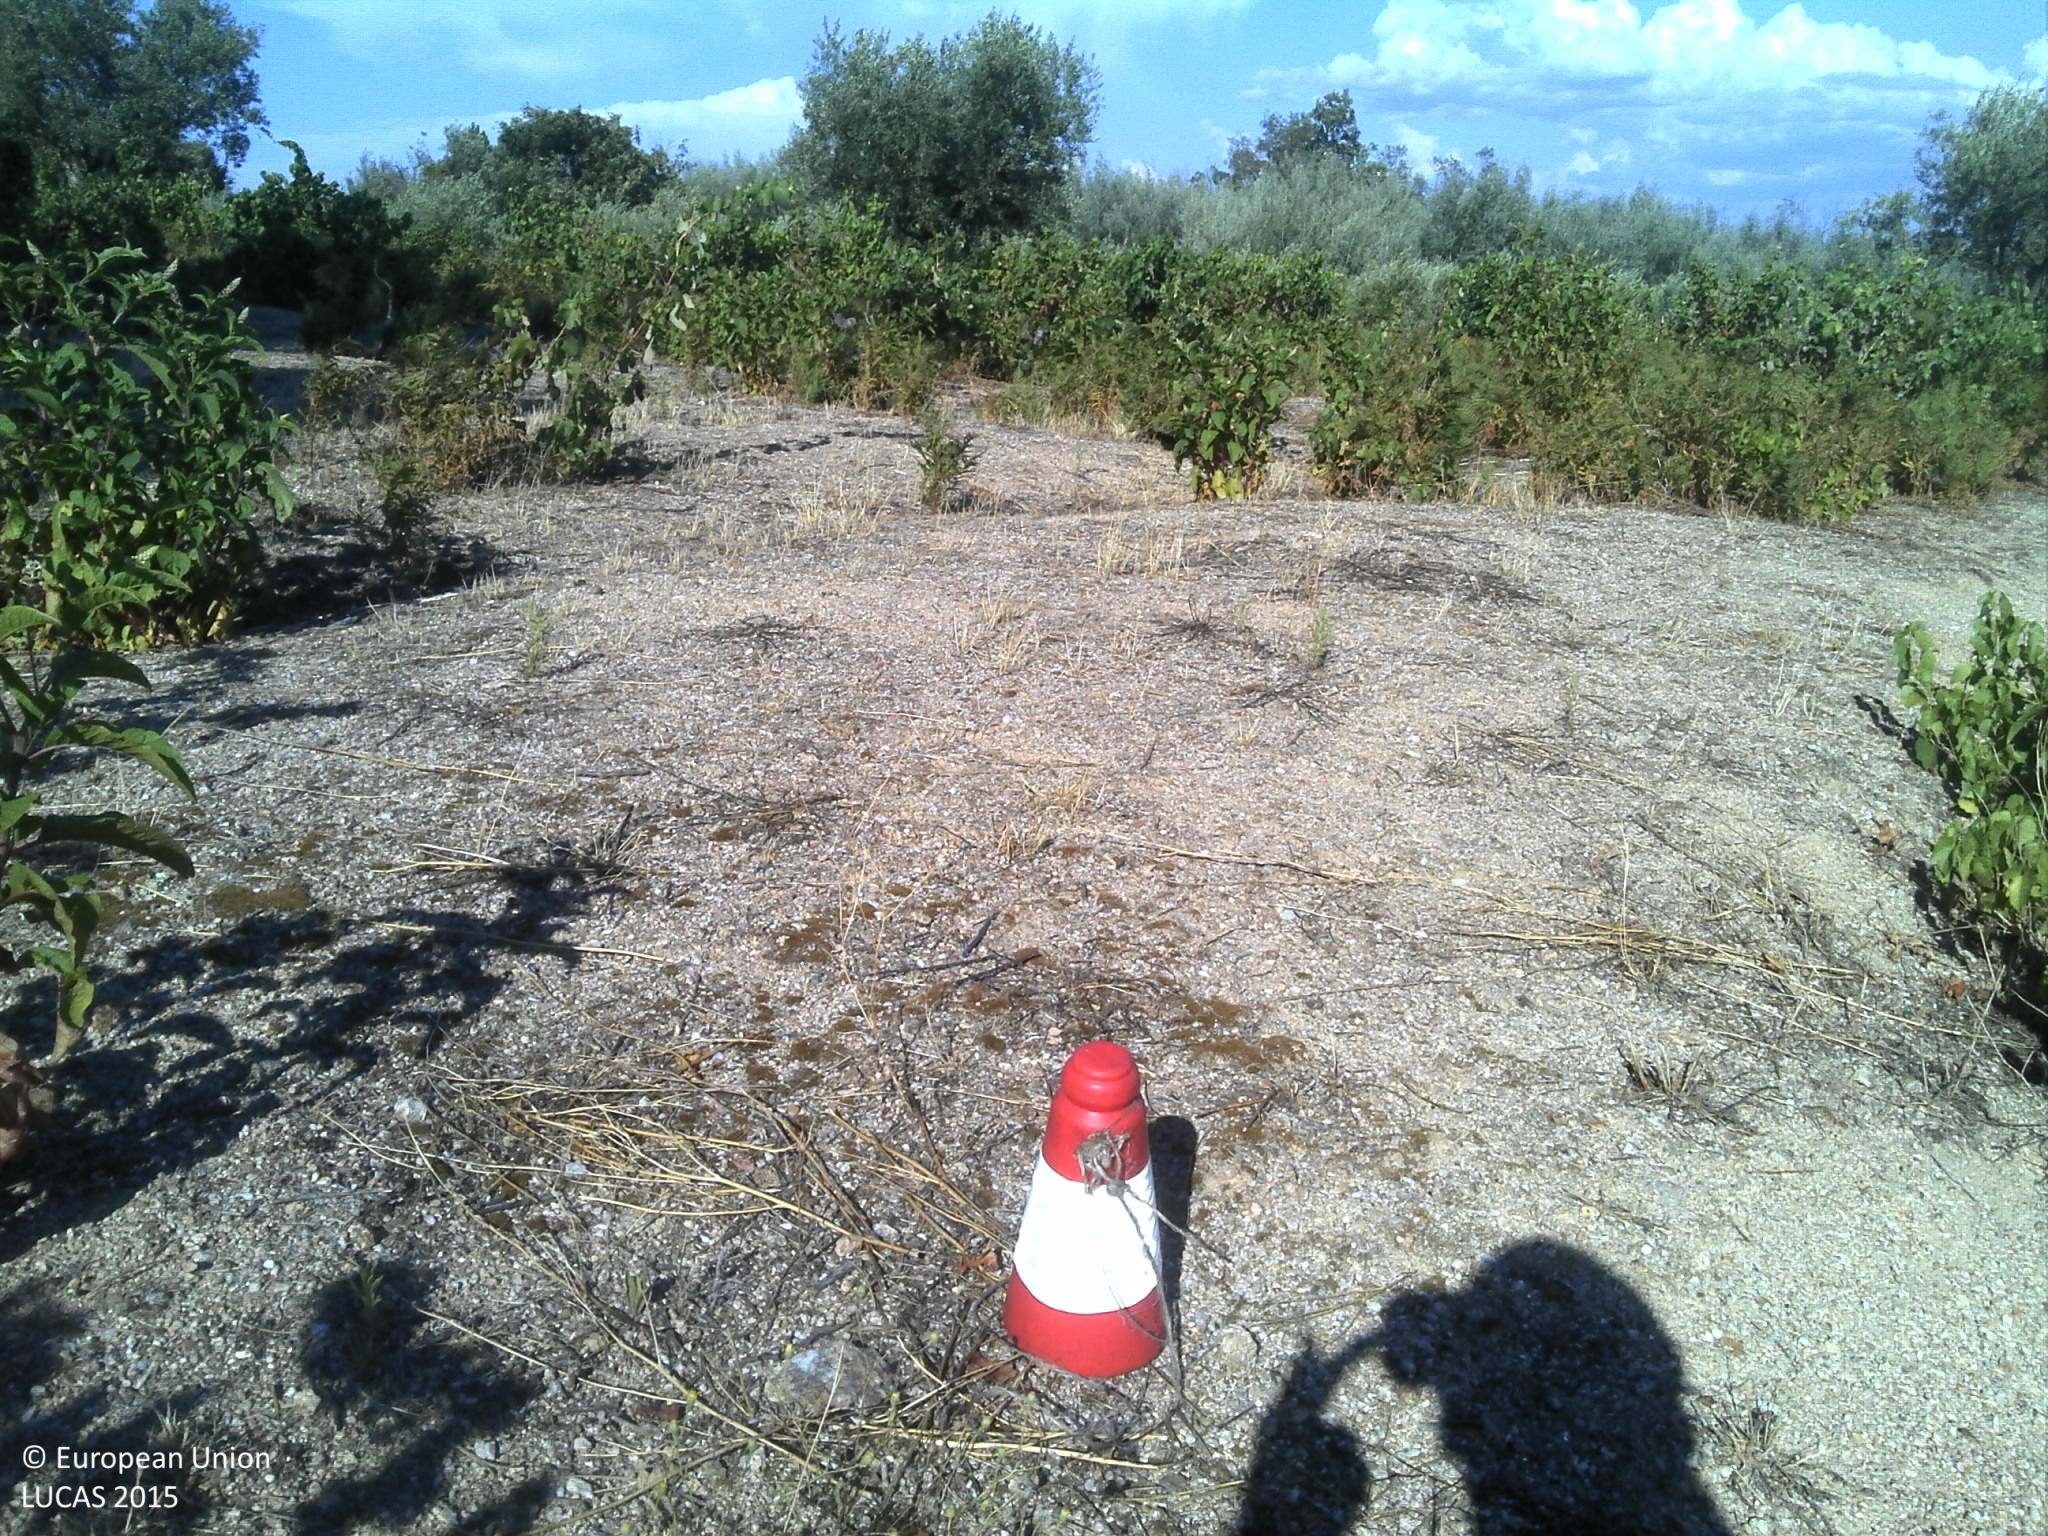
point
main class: Cropland
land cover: Vineyards
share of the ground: 10 - 25 %
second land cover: Spontaneously vegetated surfaces
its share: 10 - 25 %
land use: Agriculture (excluding fallow land and kitchen gardens)
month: July
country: PT
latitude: 40.2981
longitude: -7.4351
